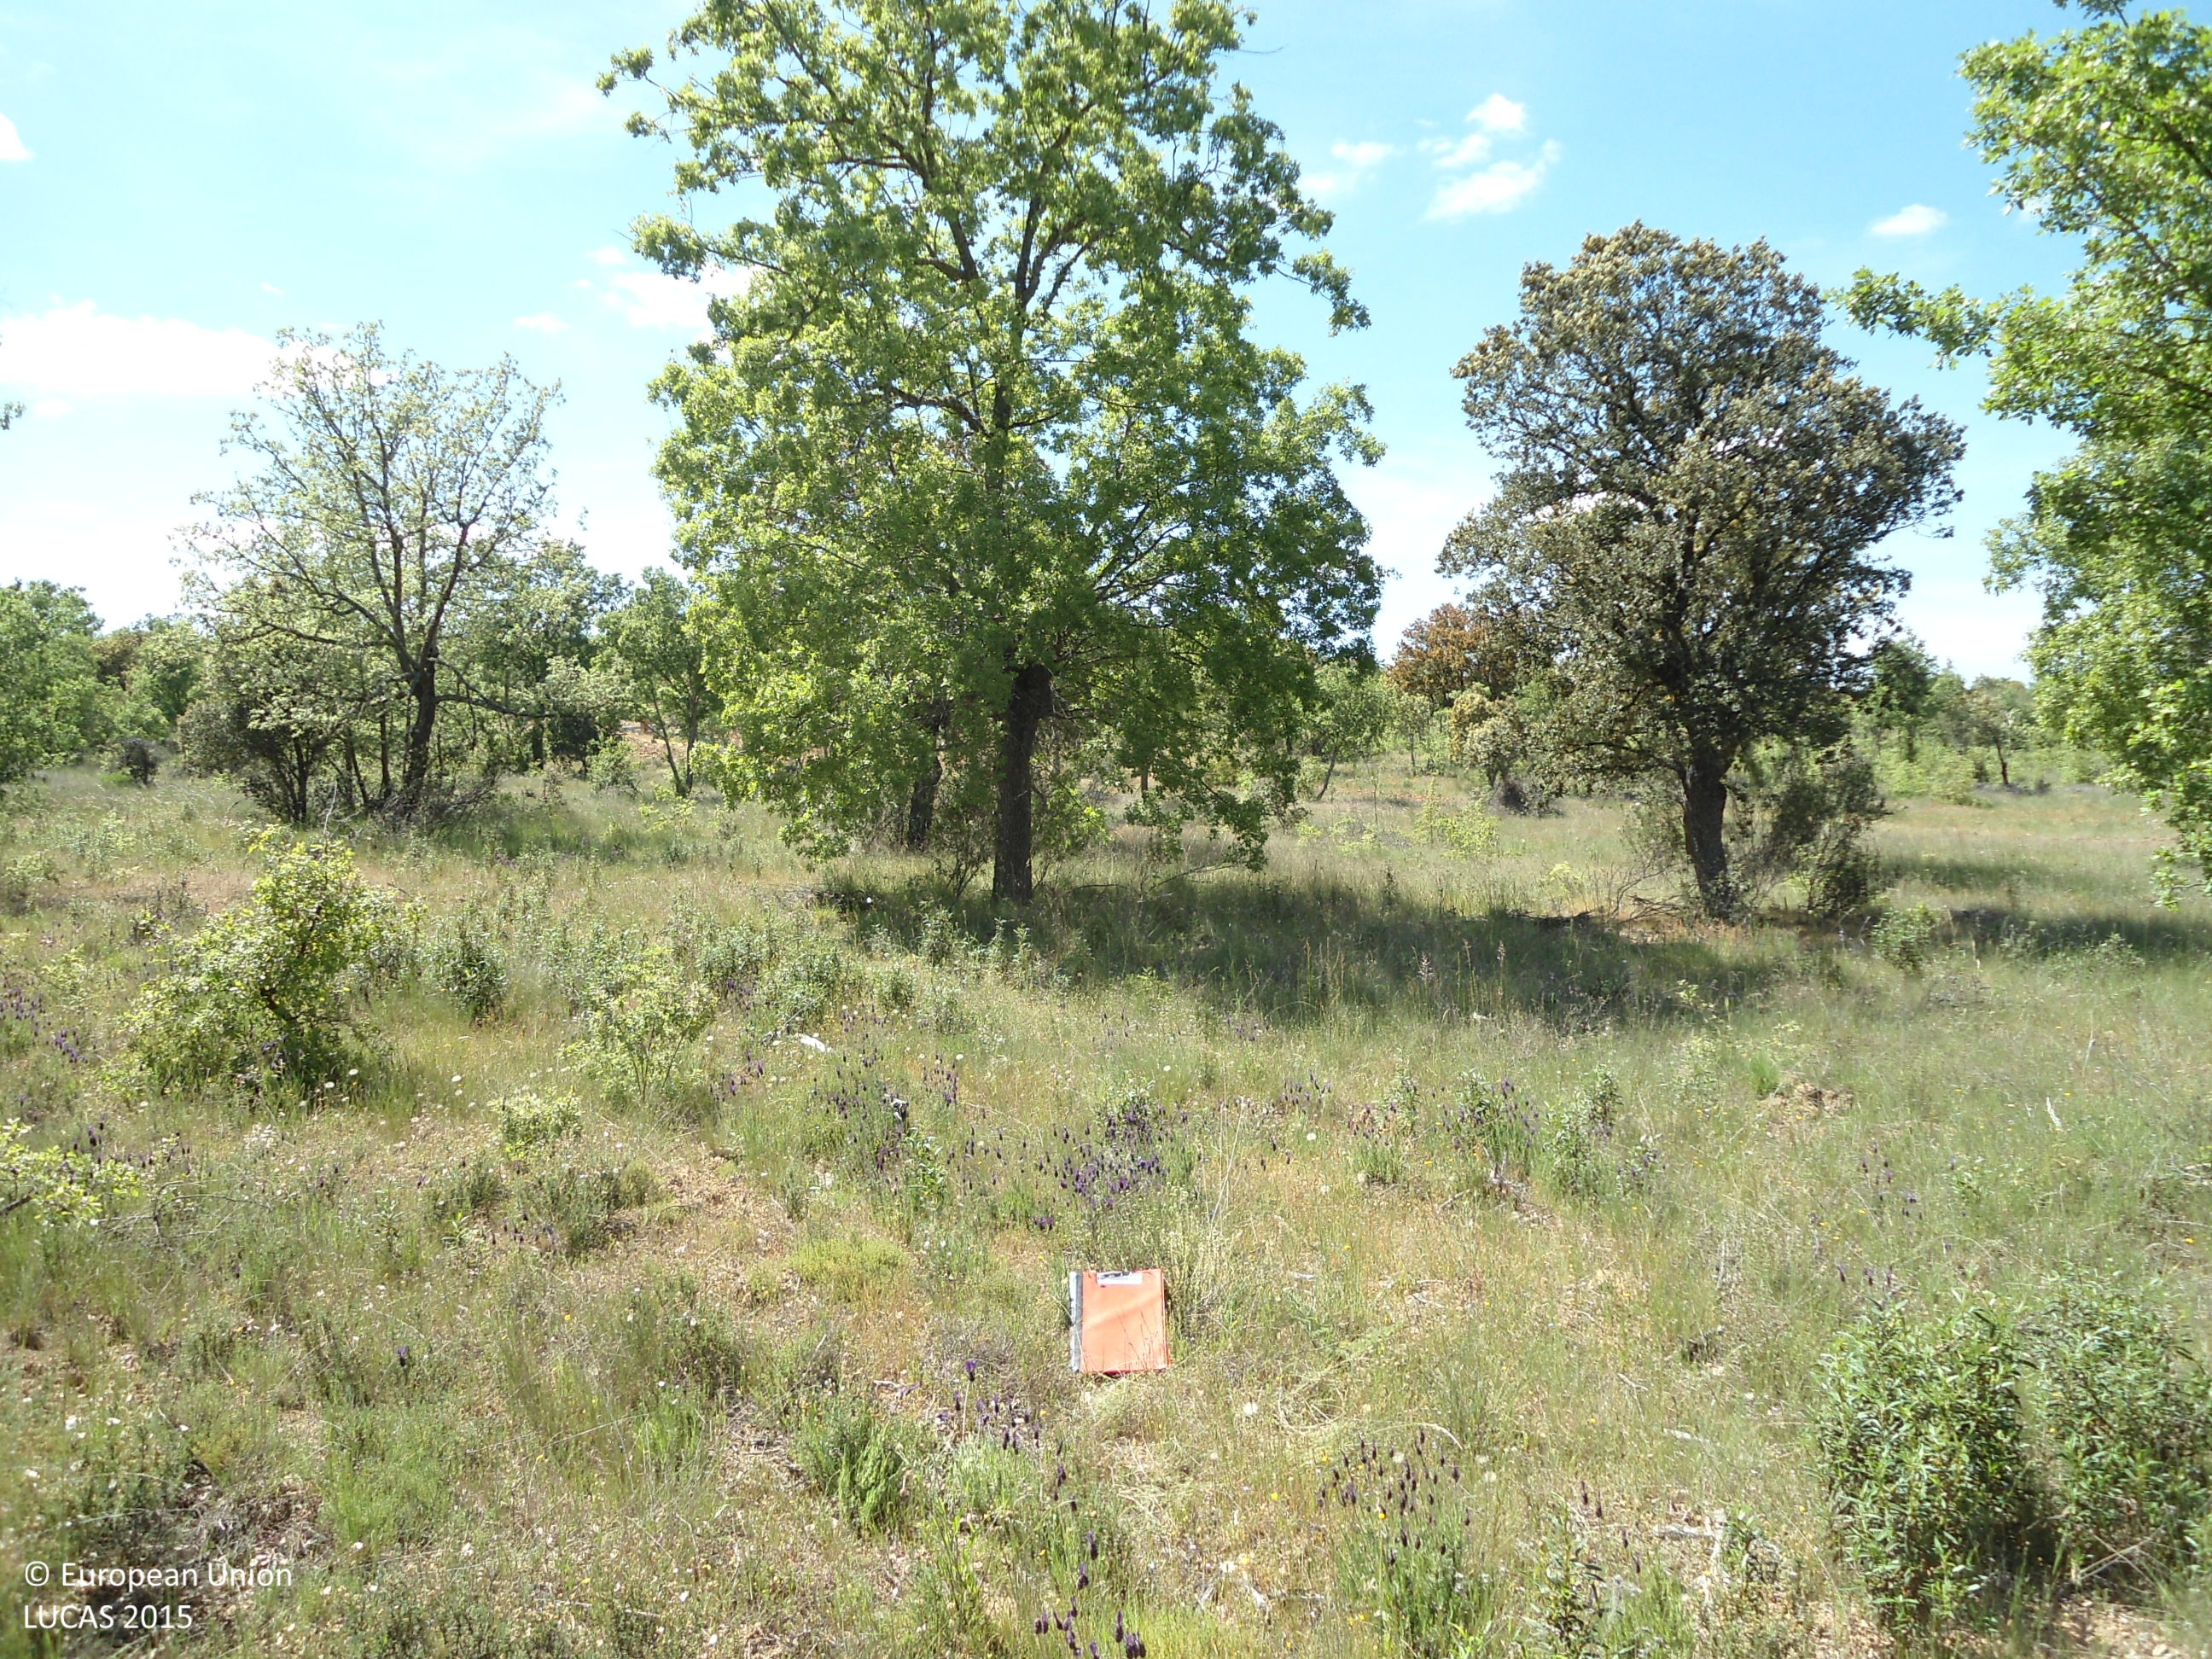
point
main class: Woodland
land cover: Broadleaved woodland
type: acidophilous oak and oak-birch forest
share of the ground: > 75 %
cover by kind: broadleaved forest trees 80 %, shrubs 10 %, herbaceous plants 10 %
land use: Forestry
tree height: > 5 m
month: May
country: ES
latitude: 41.9095
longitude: -5.9742
